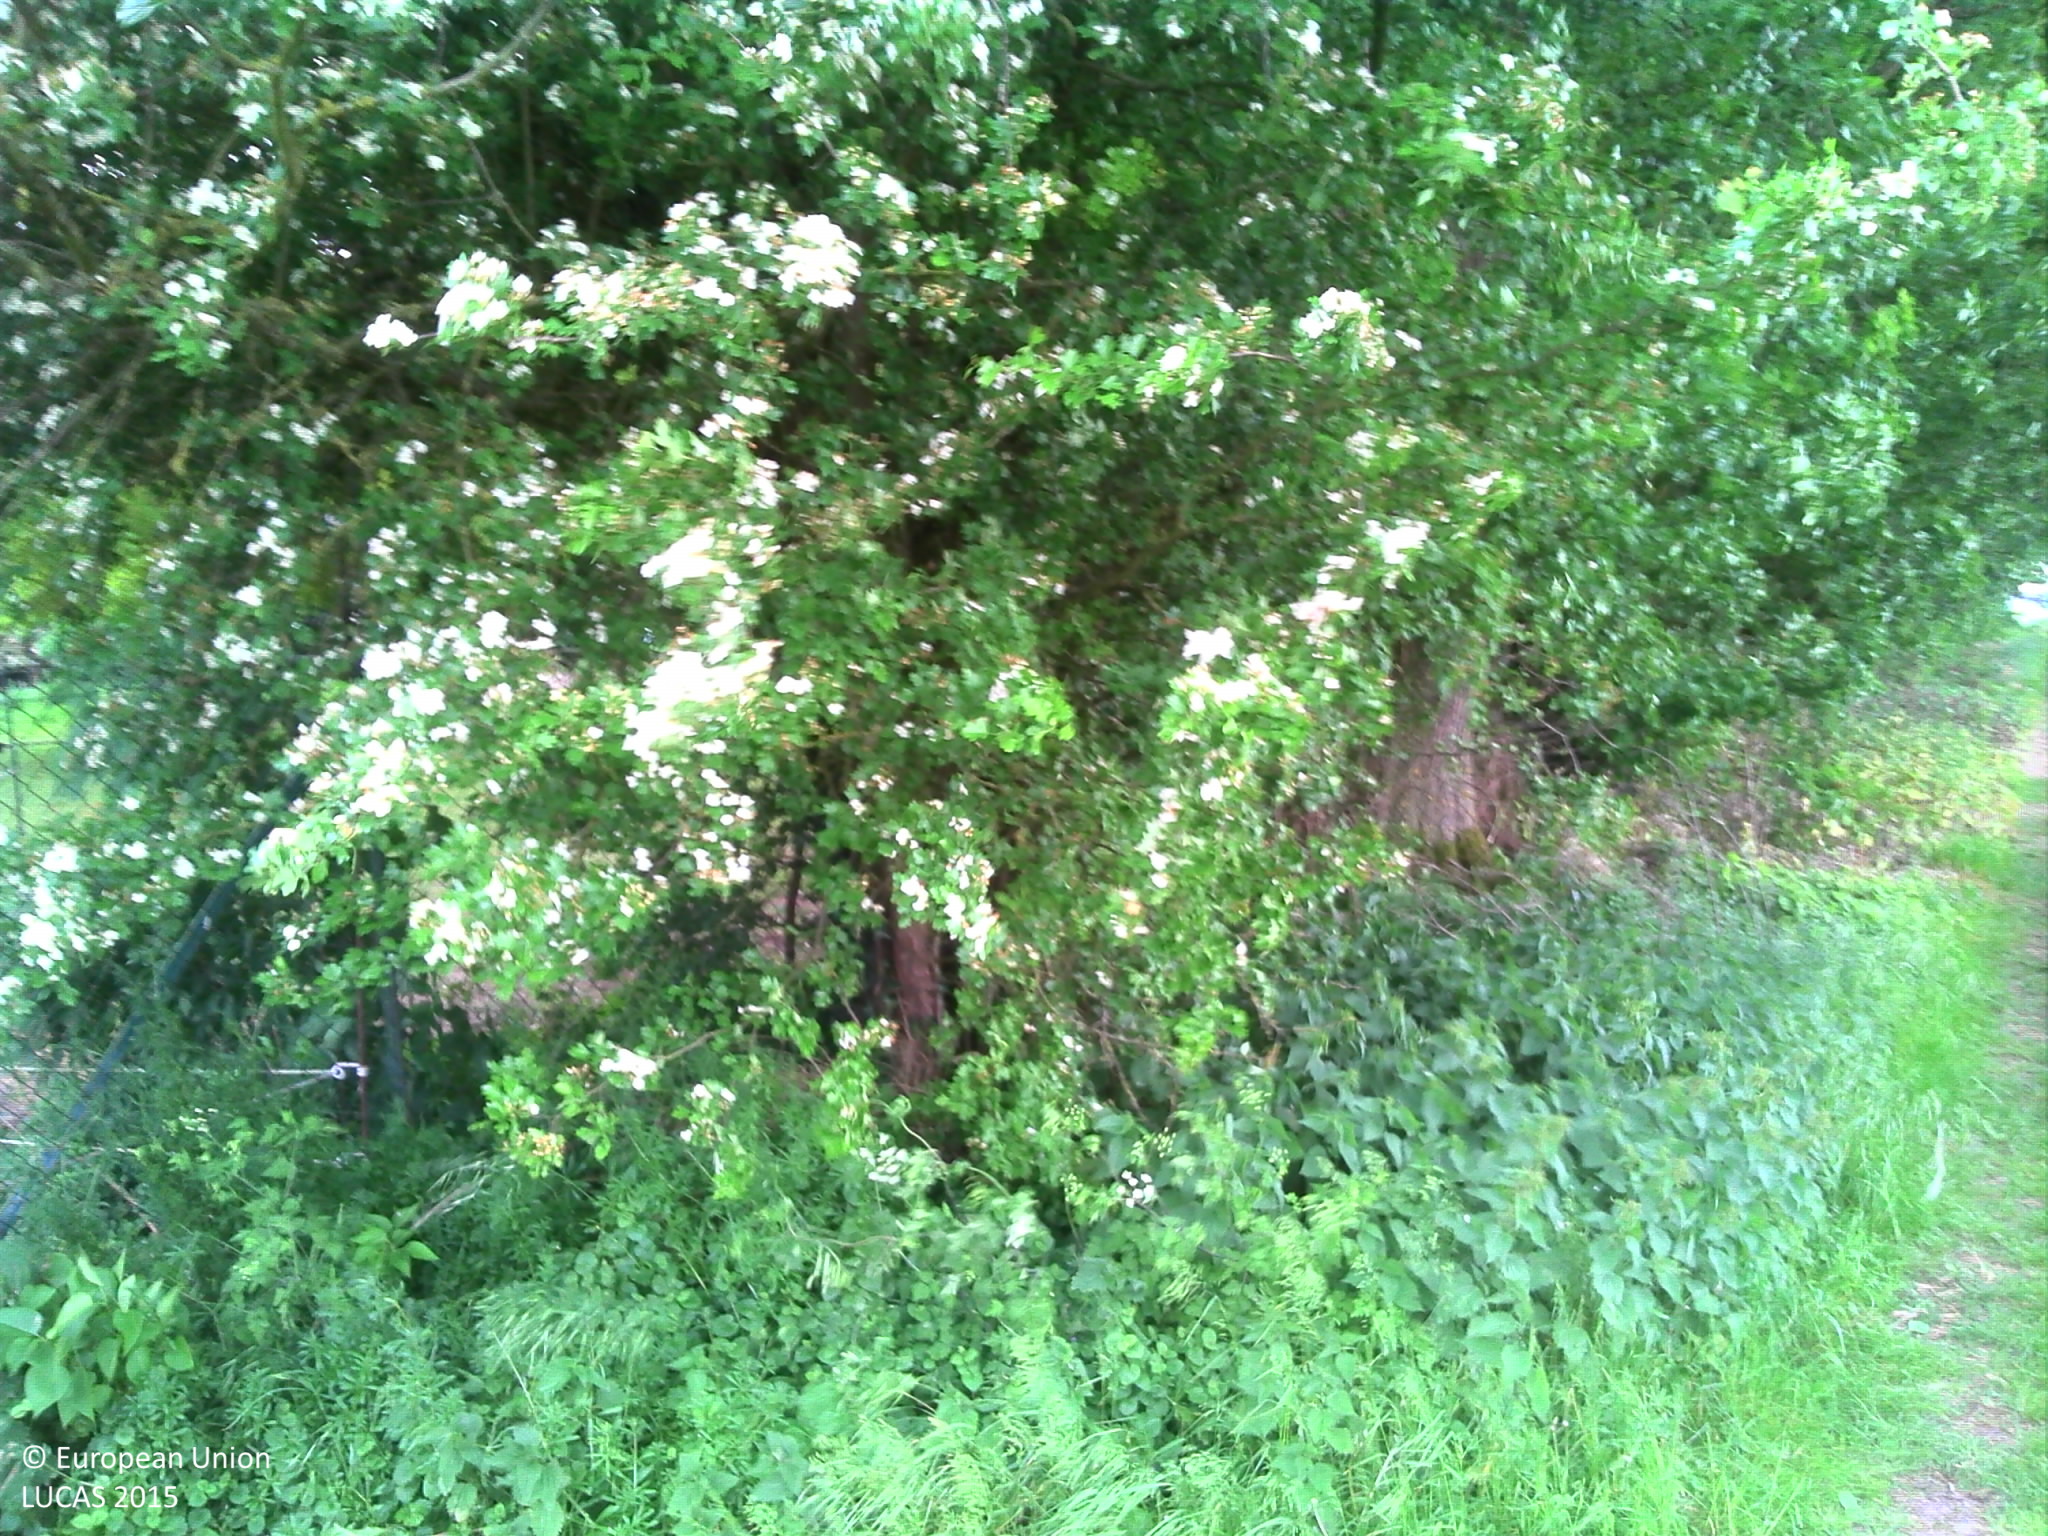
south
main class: Grassland
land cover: Grassland with sparse tree/shrub cover
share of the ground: > 75 %
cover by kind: herbaceous plants 95 %, broadleaved forest trees 5 %
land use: Residential
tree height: > 5 m
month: May
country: FR
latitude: 49.8380
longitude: 3.2200
